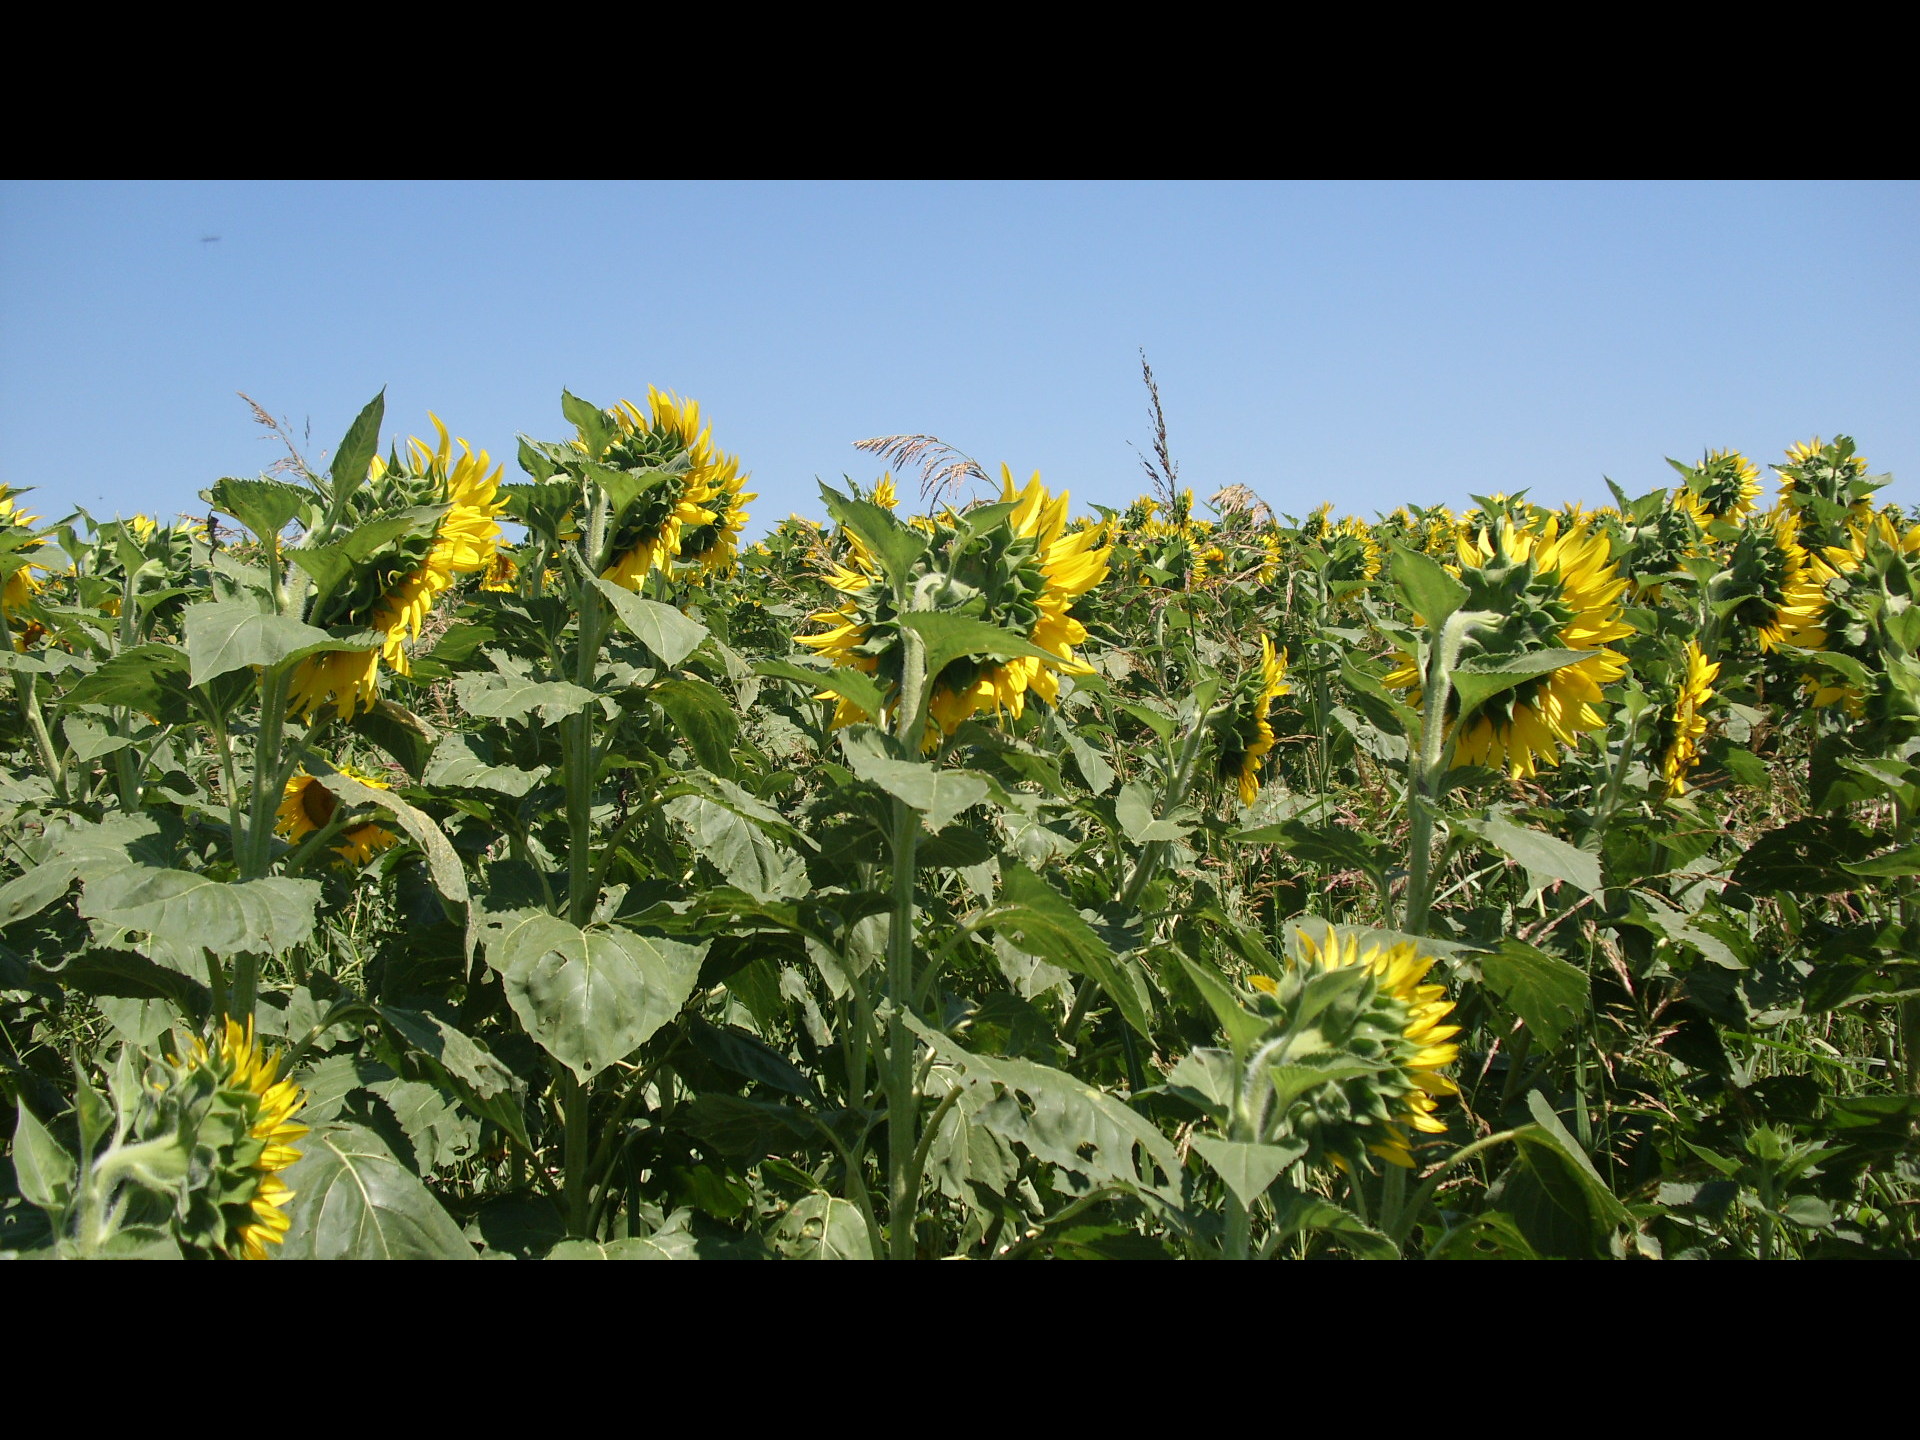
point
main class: Cropland
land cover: Sunflower
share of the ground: > 75 %
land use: Agriculture (excluding fallow land and kitchen gardens)
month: July
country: BG
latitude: 43.8366
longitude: 22.5830
